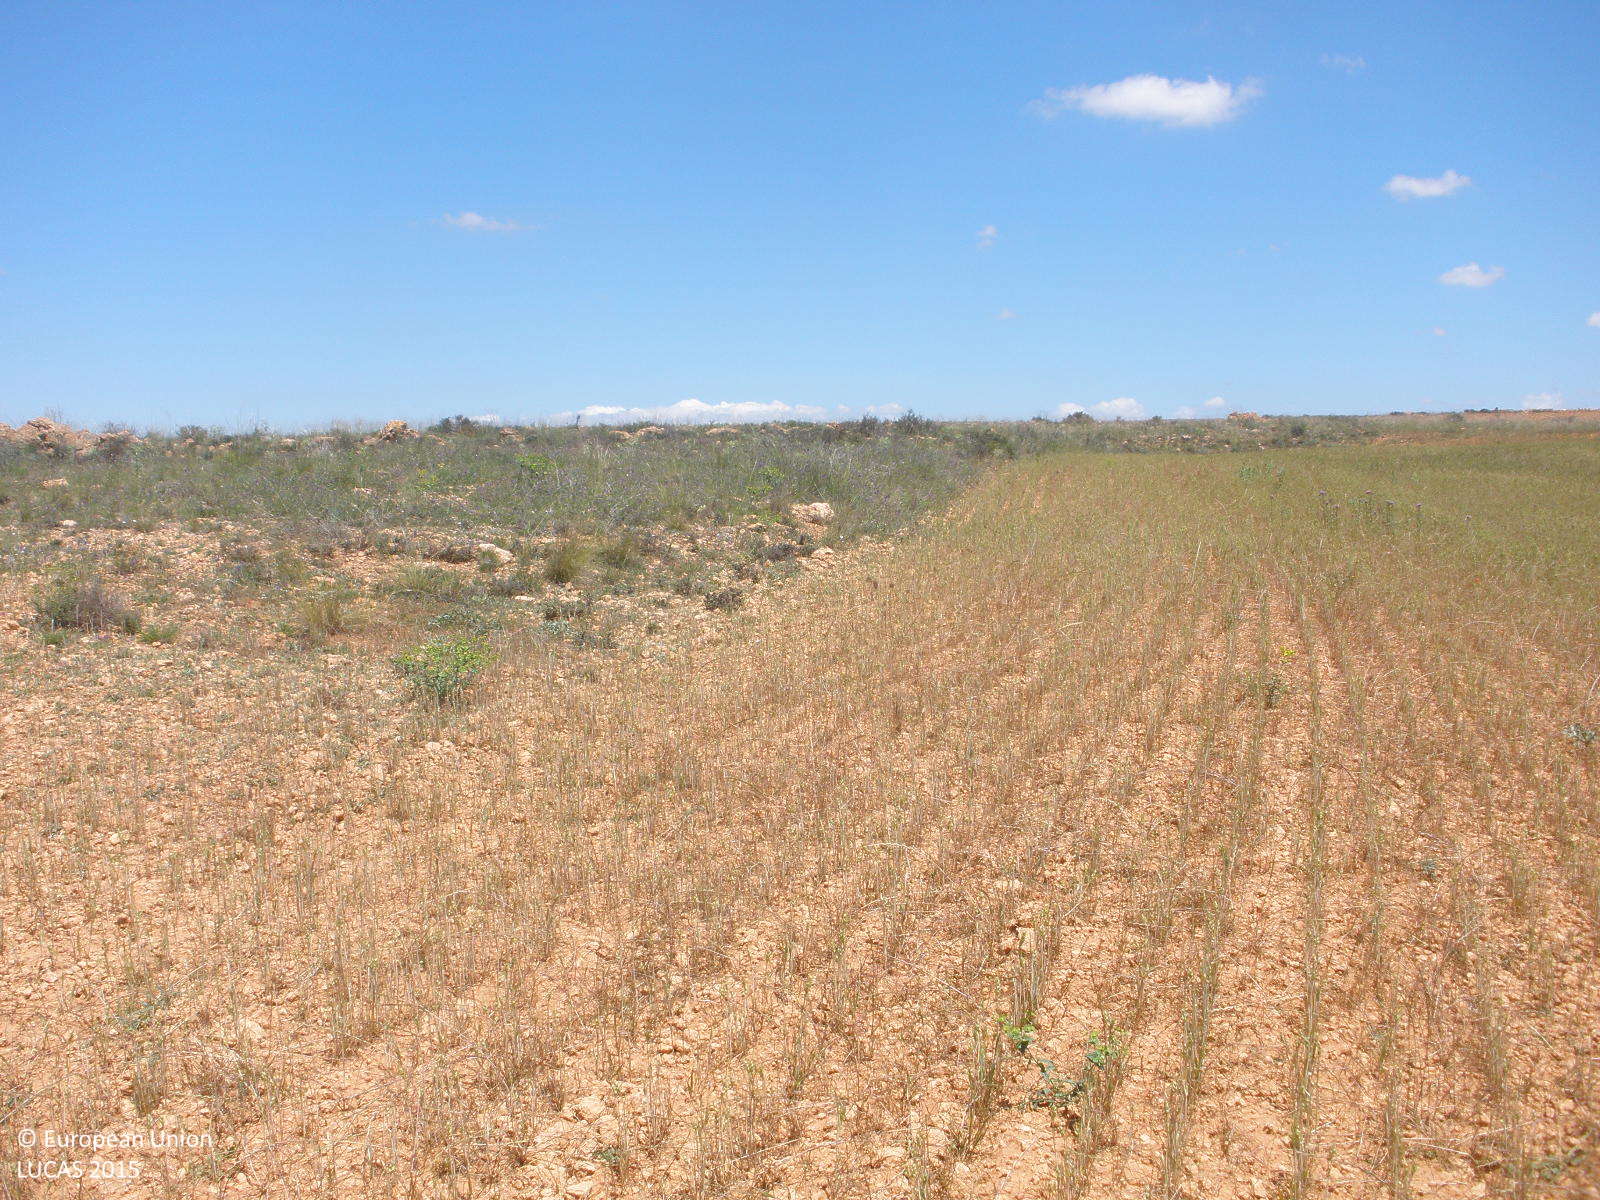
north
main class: Cropland
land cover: Common wheat
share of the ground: 50 - 75 %
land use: Agriculture (excluding fallow land and kitchen gardens)
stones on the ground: > 50 %
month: June
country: ES
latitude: 40.5885
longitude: -1.0601
